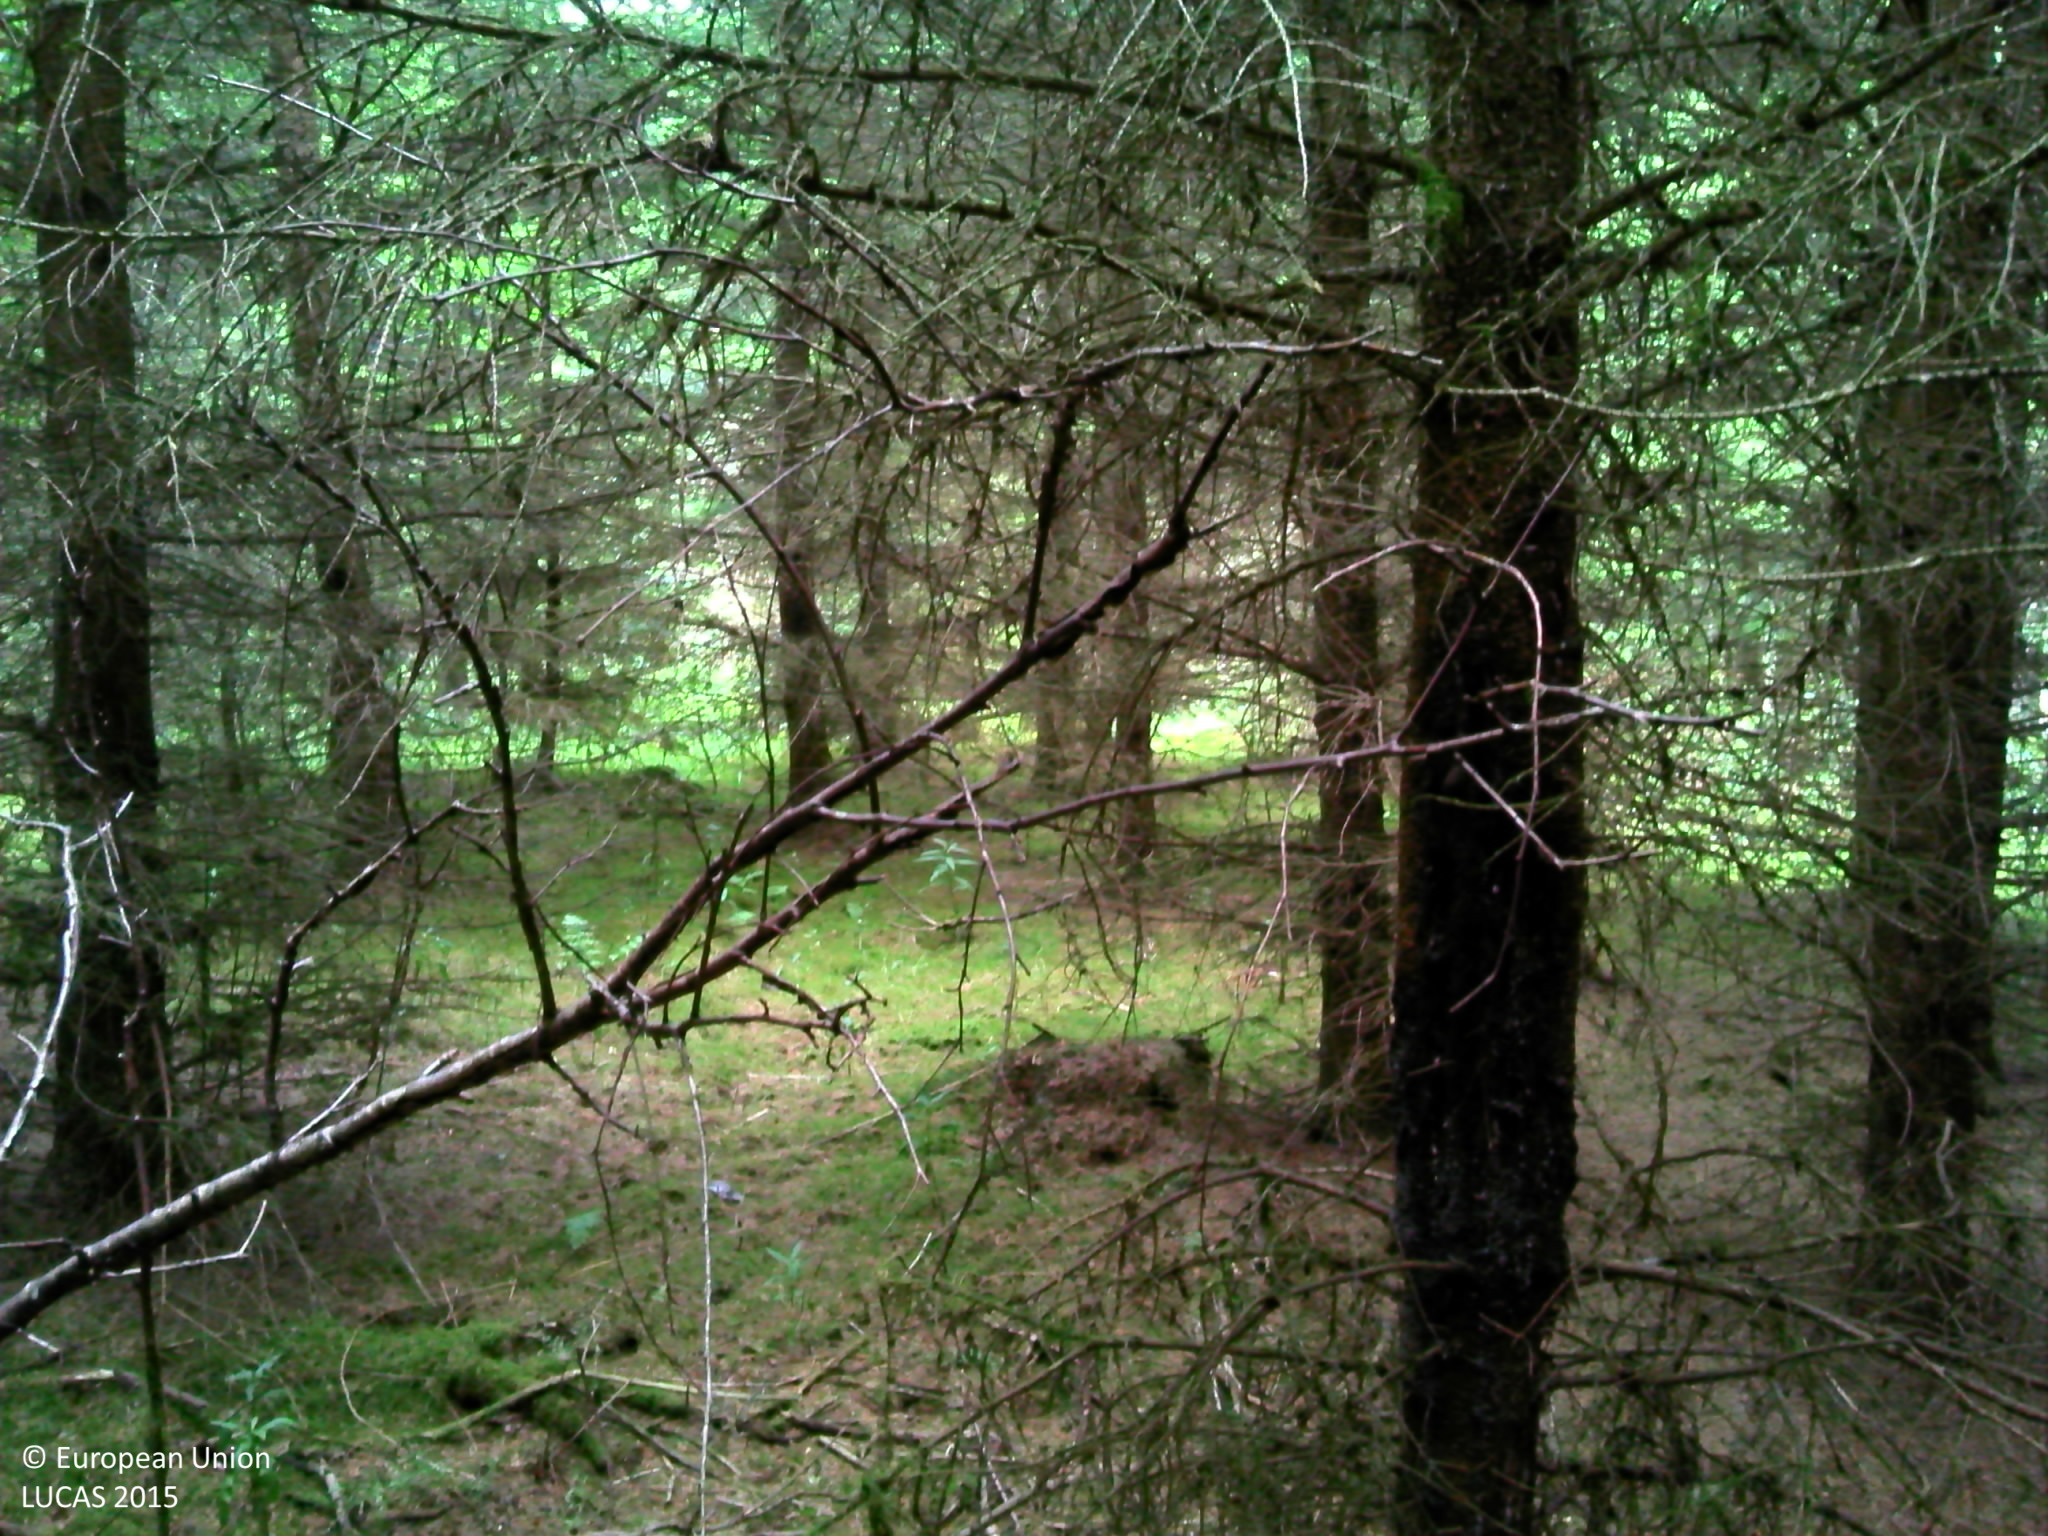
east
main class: Woodland
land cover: Spruce dominated coniferous woodland
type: hemiboreal forest and nemoral coniferous forest and mixed broadleaved-coniferous forest
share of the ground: > 75 %
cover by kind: coniferous forest trees 95 %, lichens and mosses 5 %
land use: Forestry
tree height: > 5 m
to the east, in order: Spruce dominated coniferous woodland; Spontaneously vegetated surfaces; Rivers and streams; Spontaneously vegetated surfaces
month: July
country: BE
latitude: 49.7930
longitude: 5.5950
